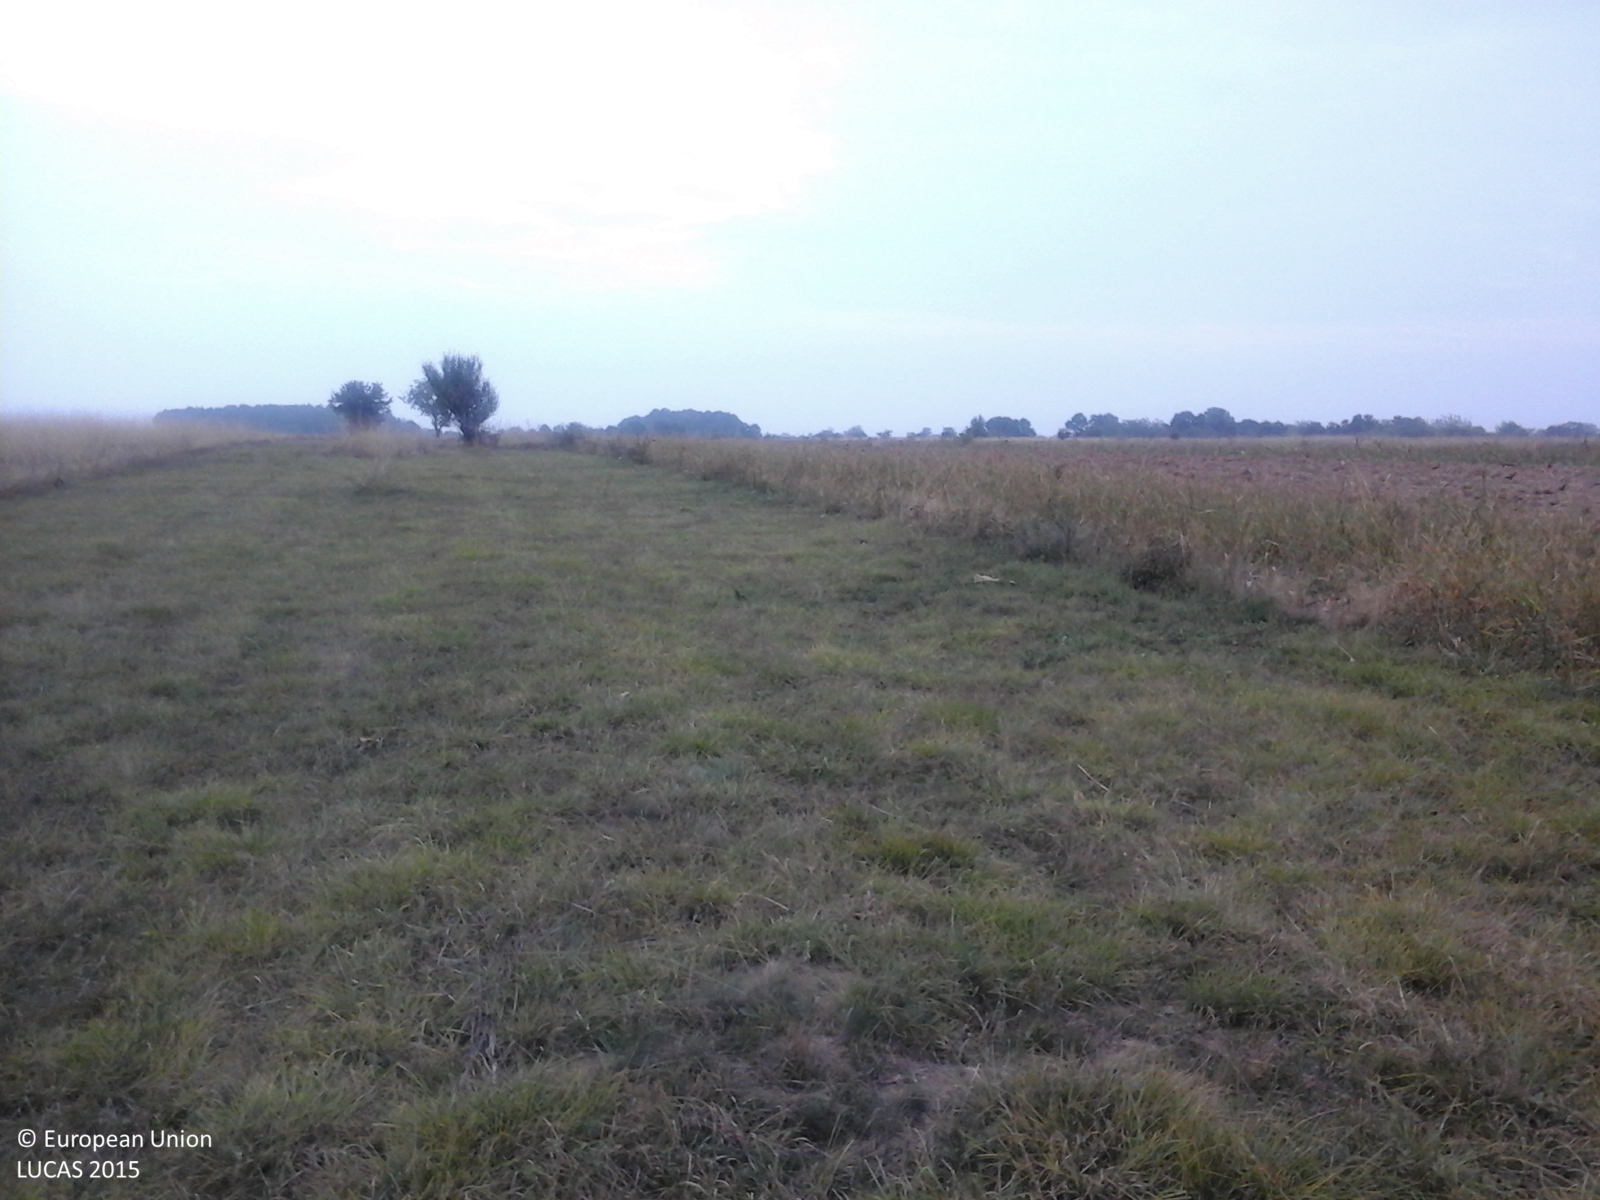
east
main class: Grassland
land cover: Grassland without tree/shrub cover
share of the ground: > 75 %
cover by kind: herbaceous plants 100 %
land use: Agriculture (excluding fallow land and kitchen gardens)
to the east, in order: Grassland without tree/shrub cover; Maize; Other bare soil; Common wheat; Maize
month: September
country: RO
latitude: 44.9556
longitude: 23.4033
